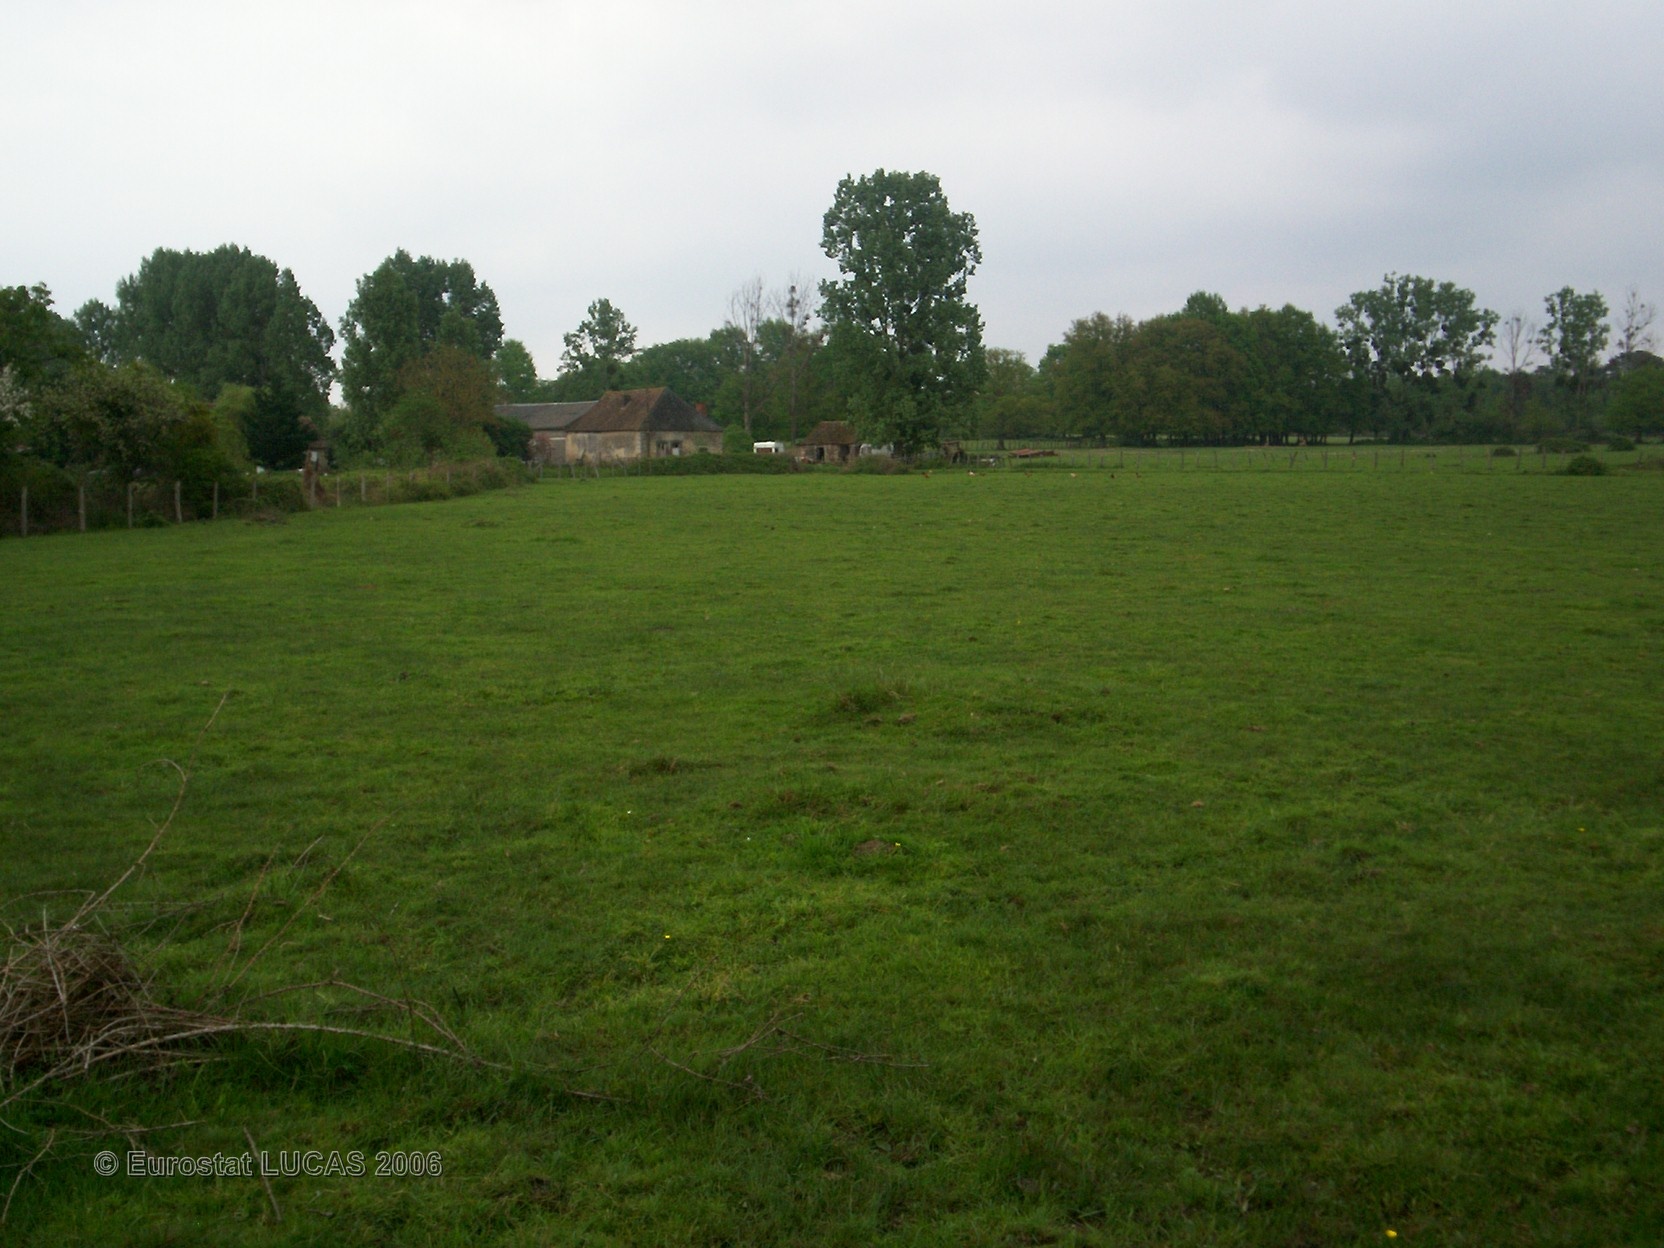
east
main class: Grassland
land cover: Grassland without tree/shrub cover
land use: Agriculture (excluding fallow land and kitchen gardens)
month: May
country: FR
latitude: 47.9573
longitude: 0.2929
